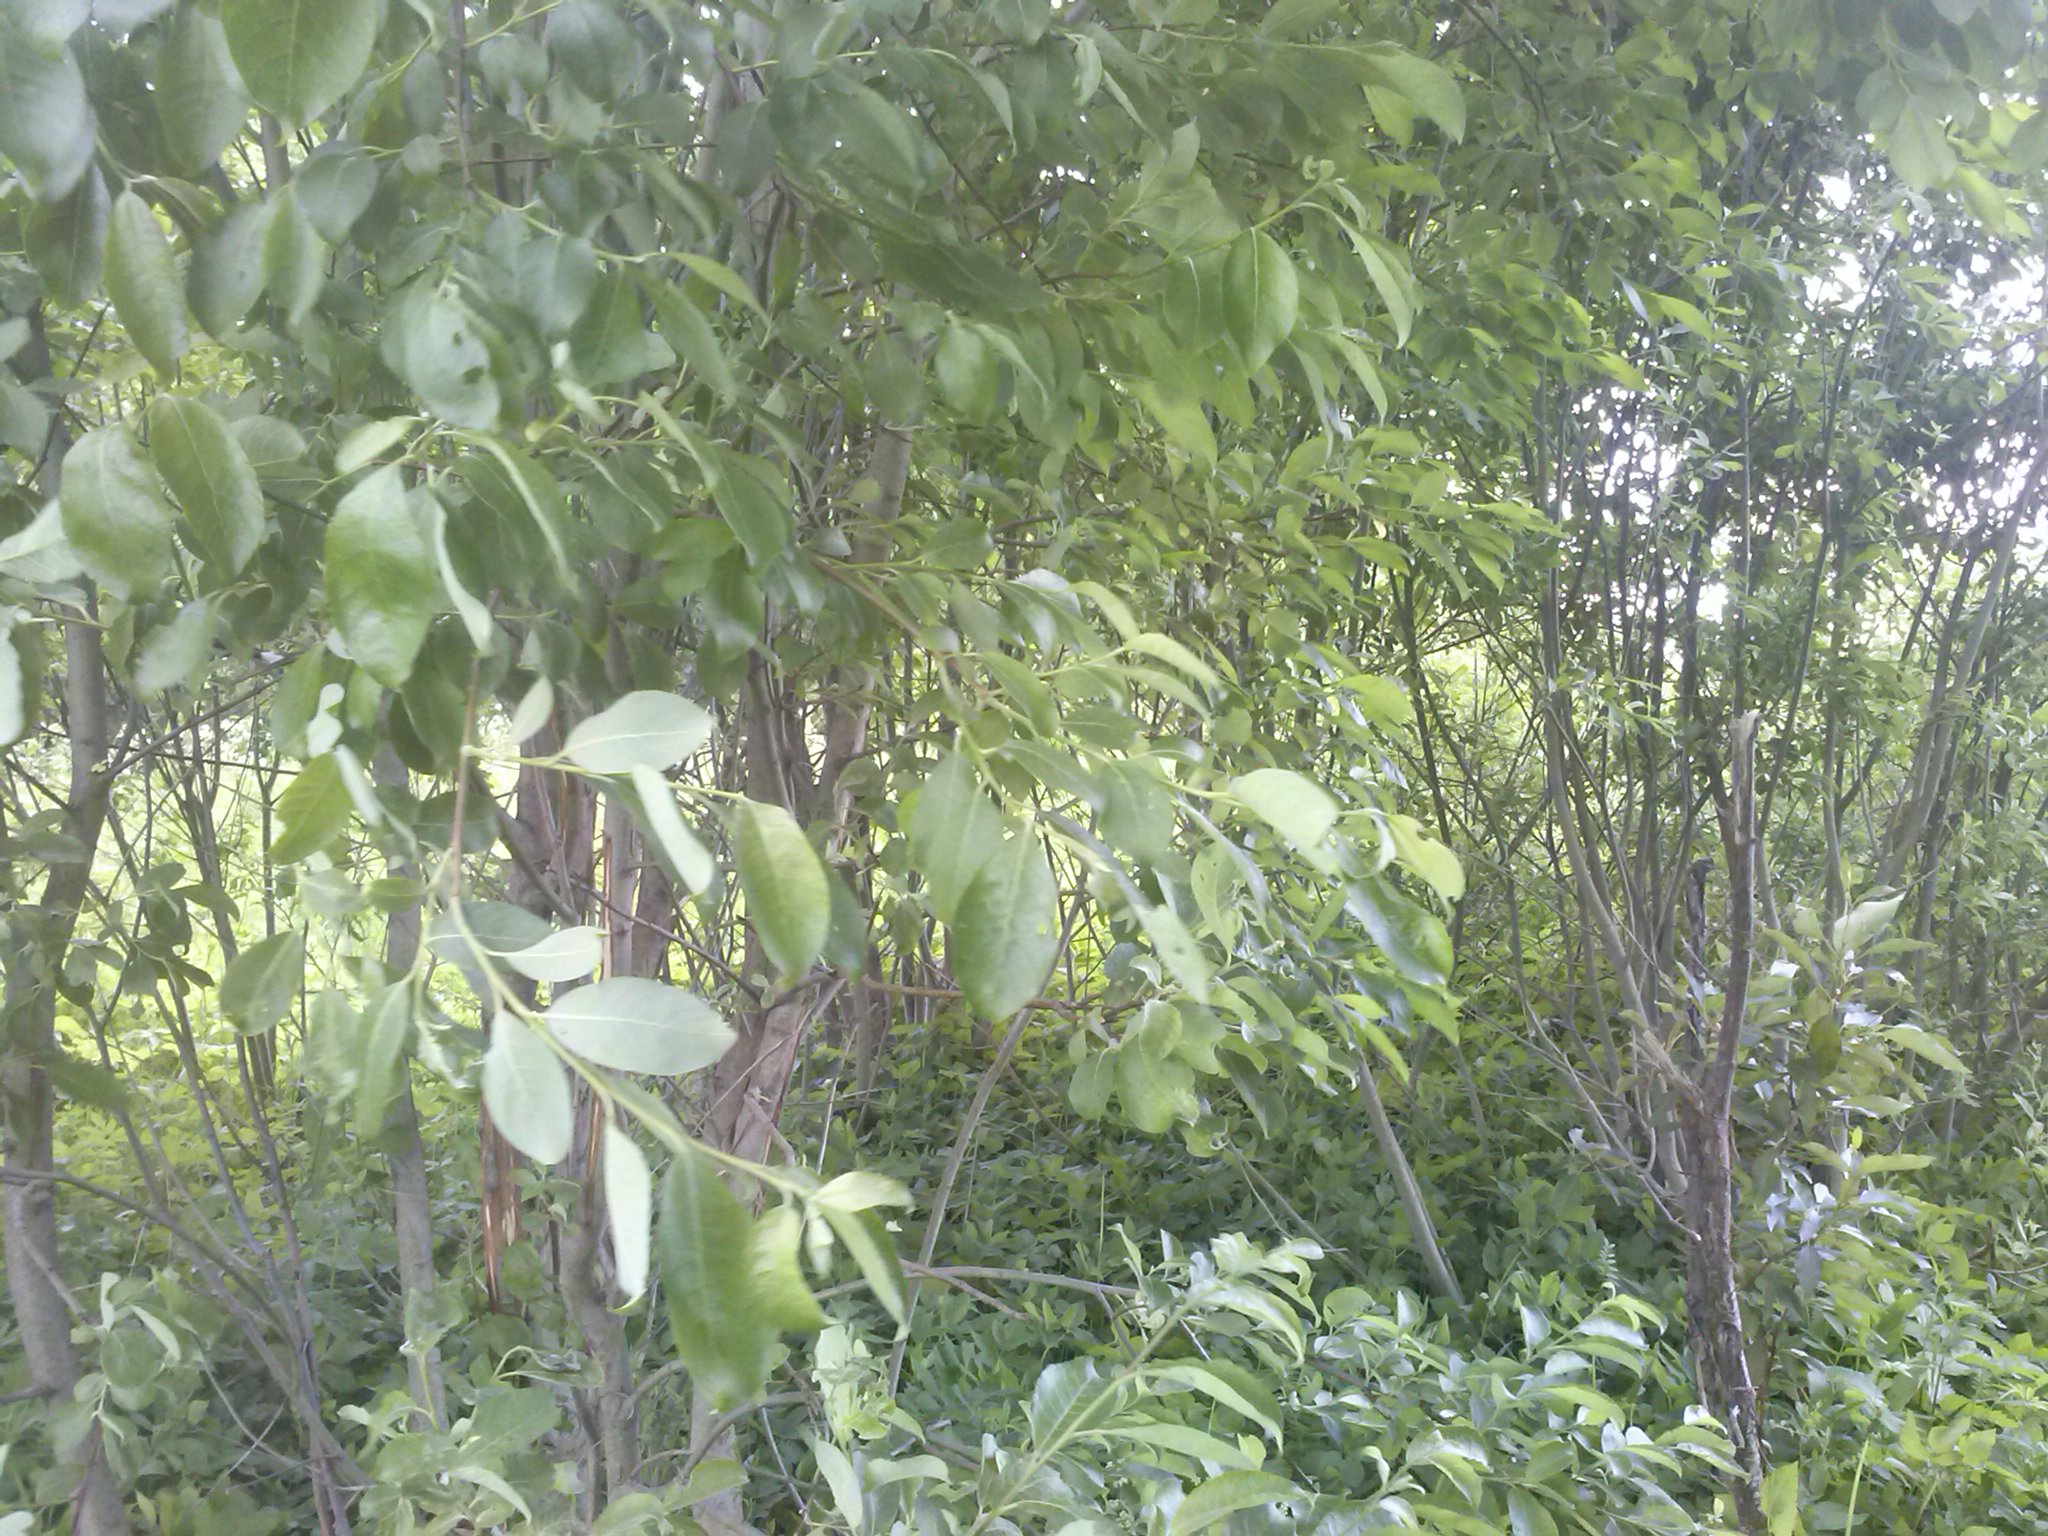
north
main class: Grassland
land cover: Grassland without tree/shrub cover
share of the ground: > 75 %
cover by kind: herbaceous plants 100 %
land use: Agriculture (excluding fallow land and kitchen gardens)
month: June
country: LV
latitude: 56.2749
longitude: 27.6764
